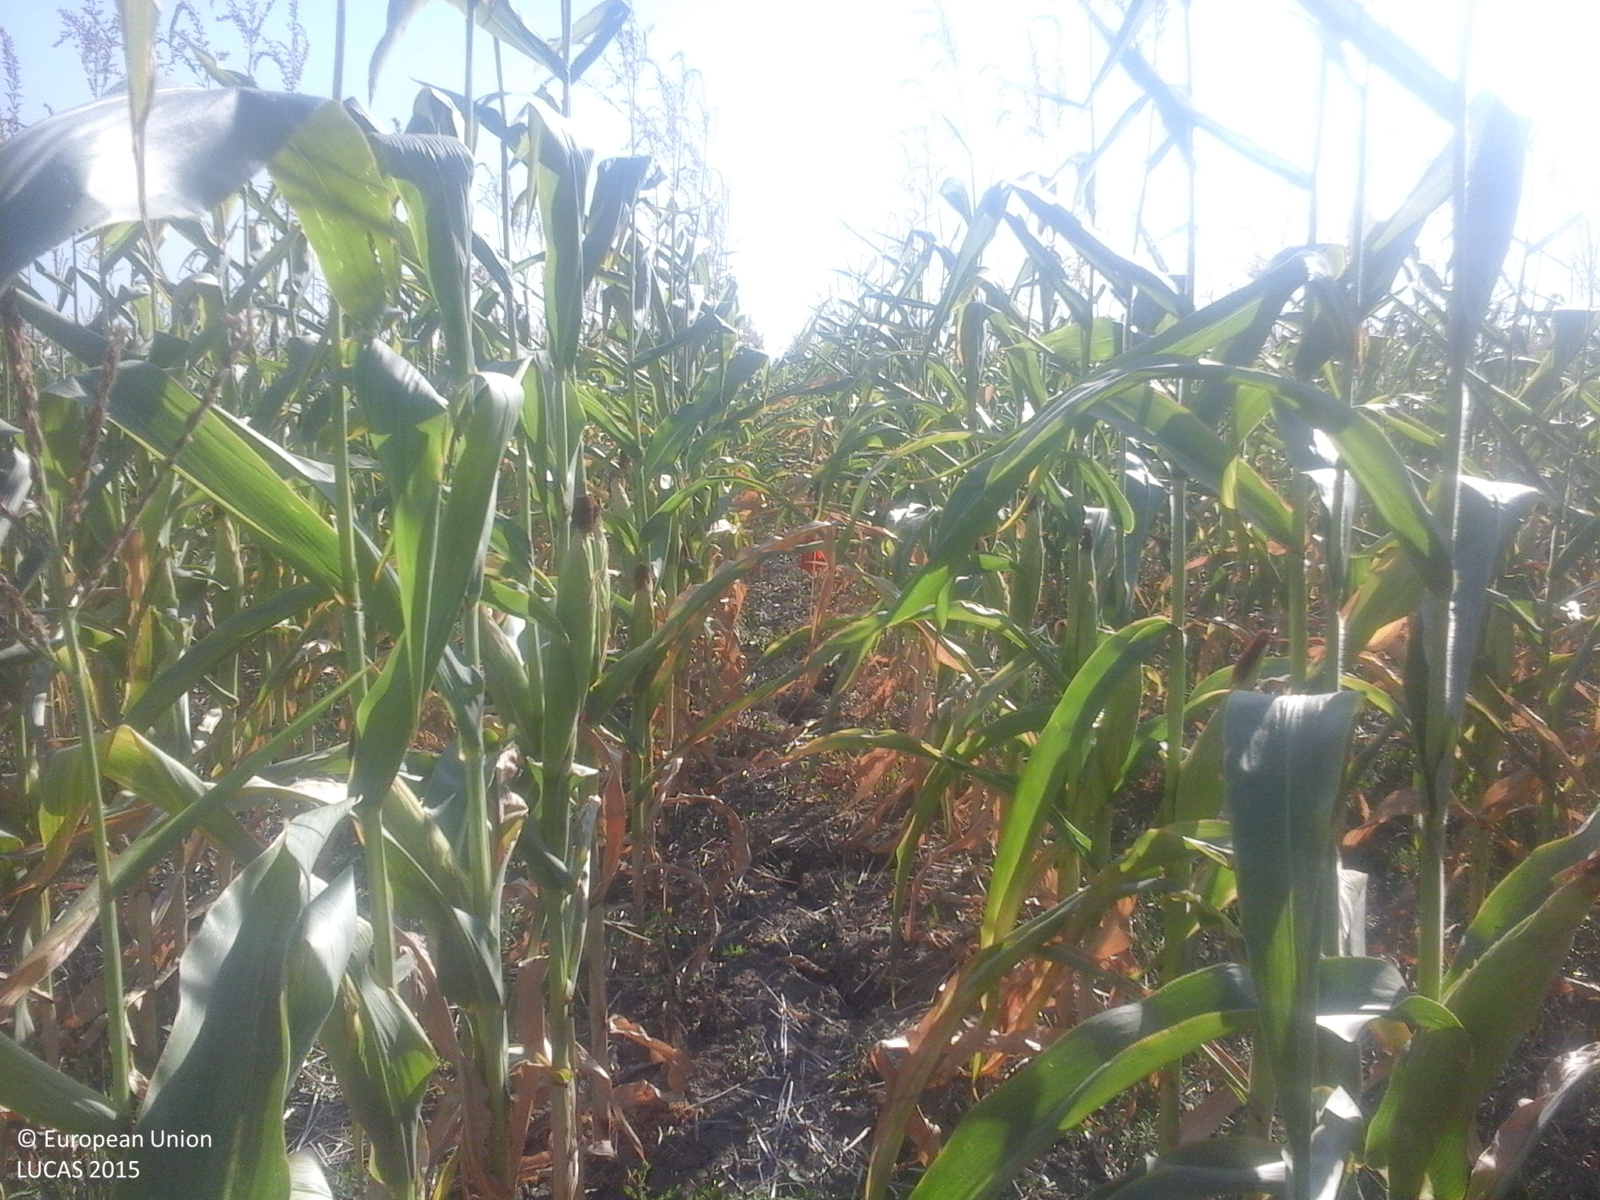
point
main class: Cropland
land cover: Maize
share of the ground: > 75 %
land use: Agriculture (excluding fallow land and kitchen gardens)
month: August
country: RO
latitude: 45.5974
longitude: 27.3675
